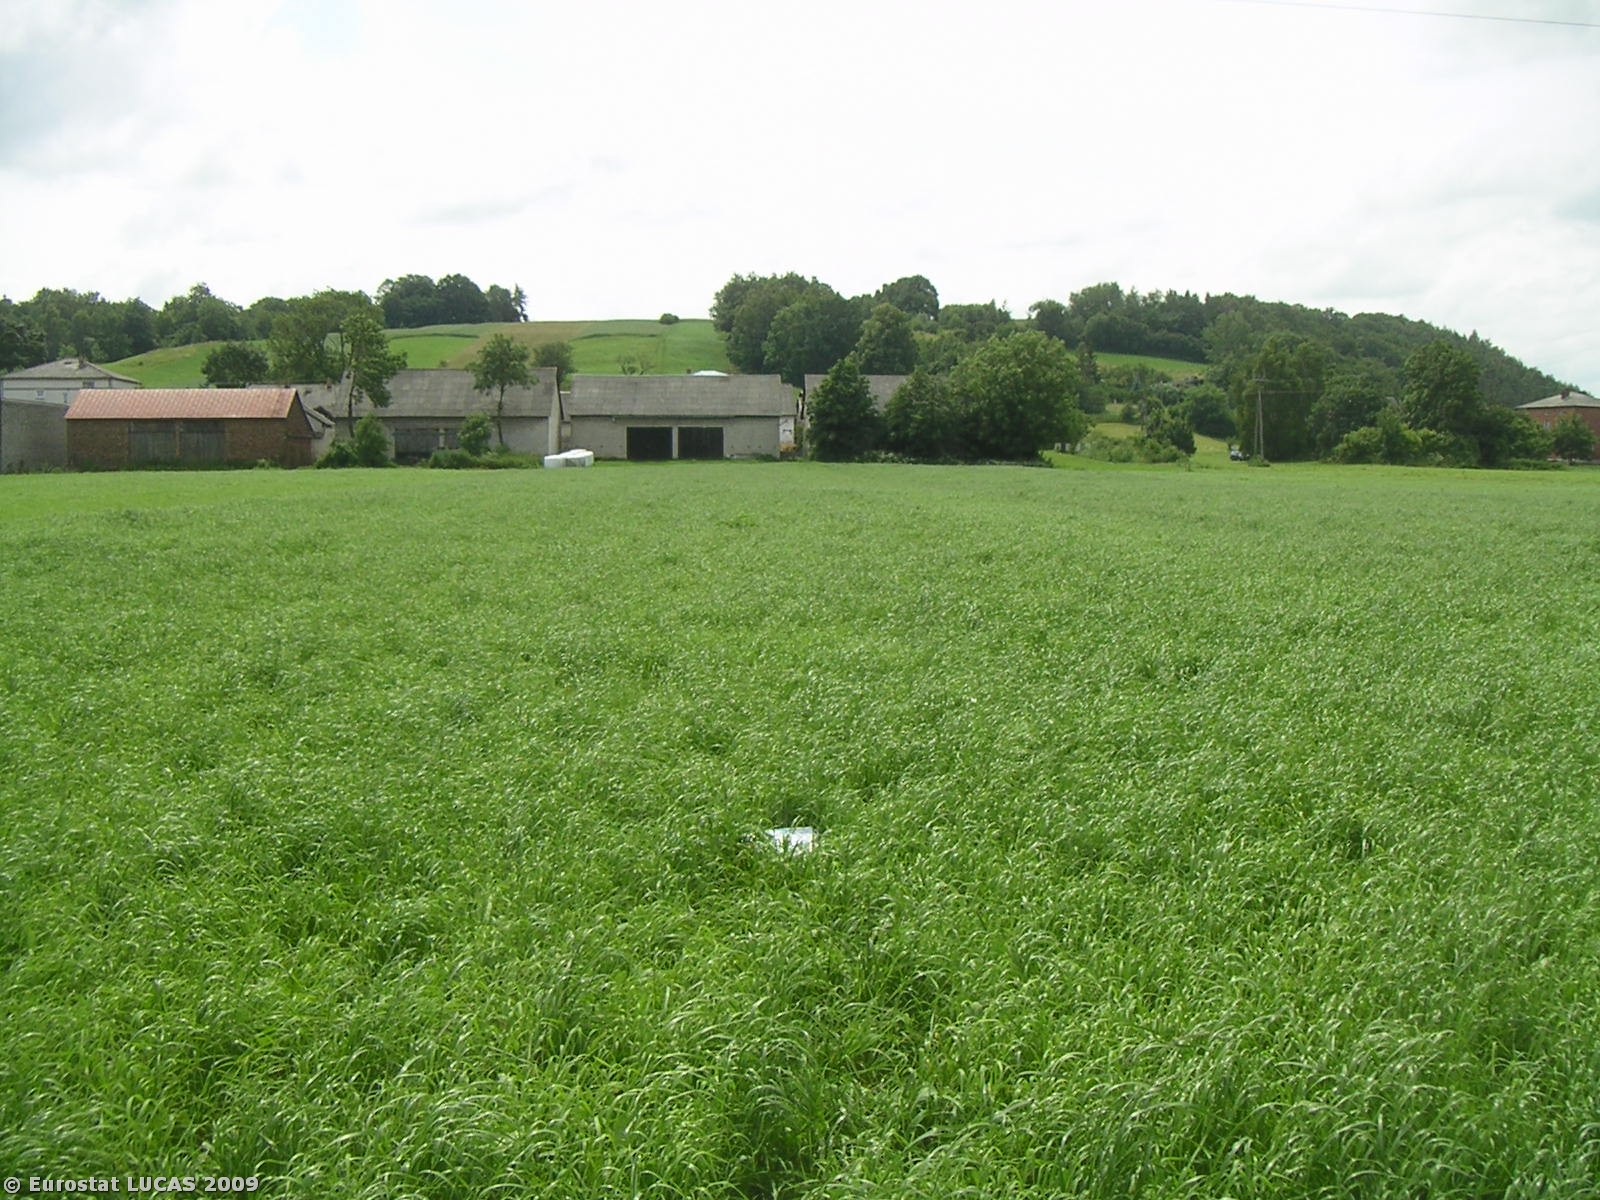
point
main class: Grassland
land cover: Grassland without tree/shrub cover
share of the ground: > 75 %
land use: Agriculture (excluding fallow land and kitchen gardens)
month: June
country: PL
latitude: 50.4729
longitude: 19.7380
